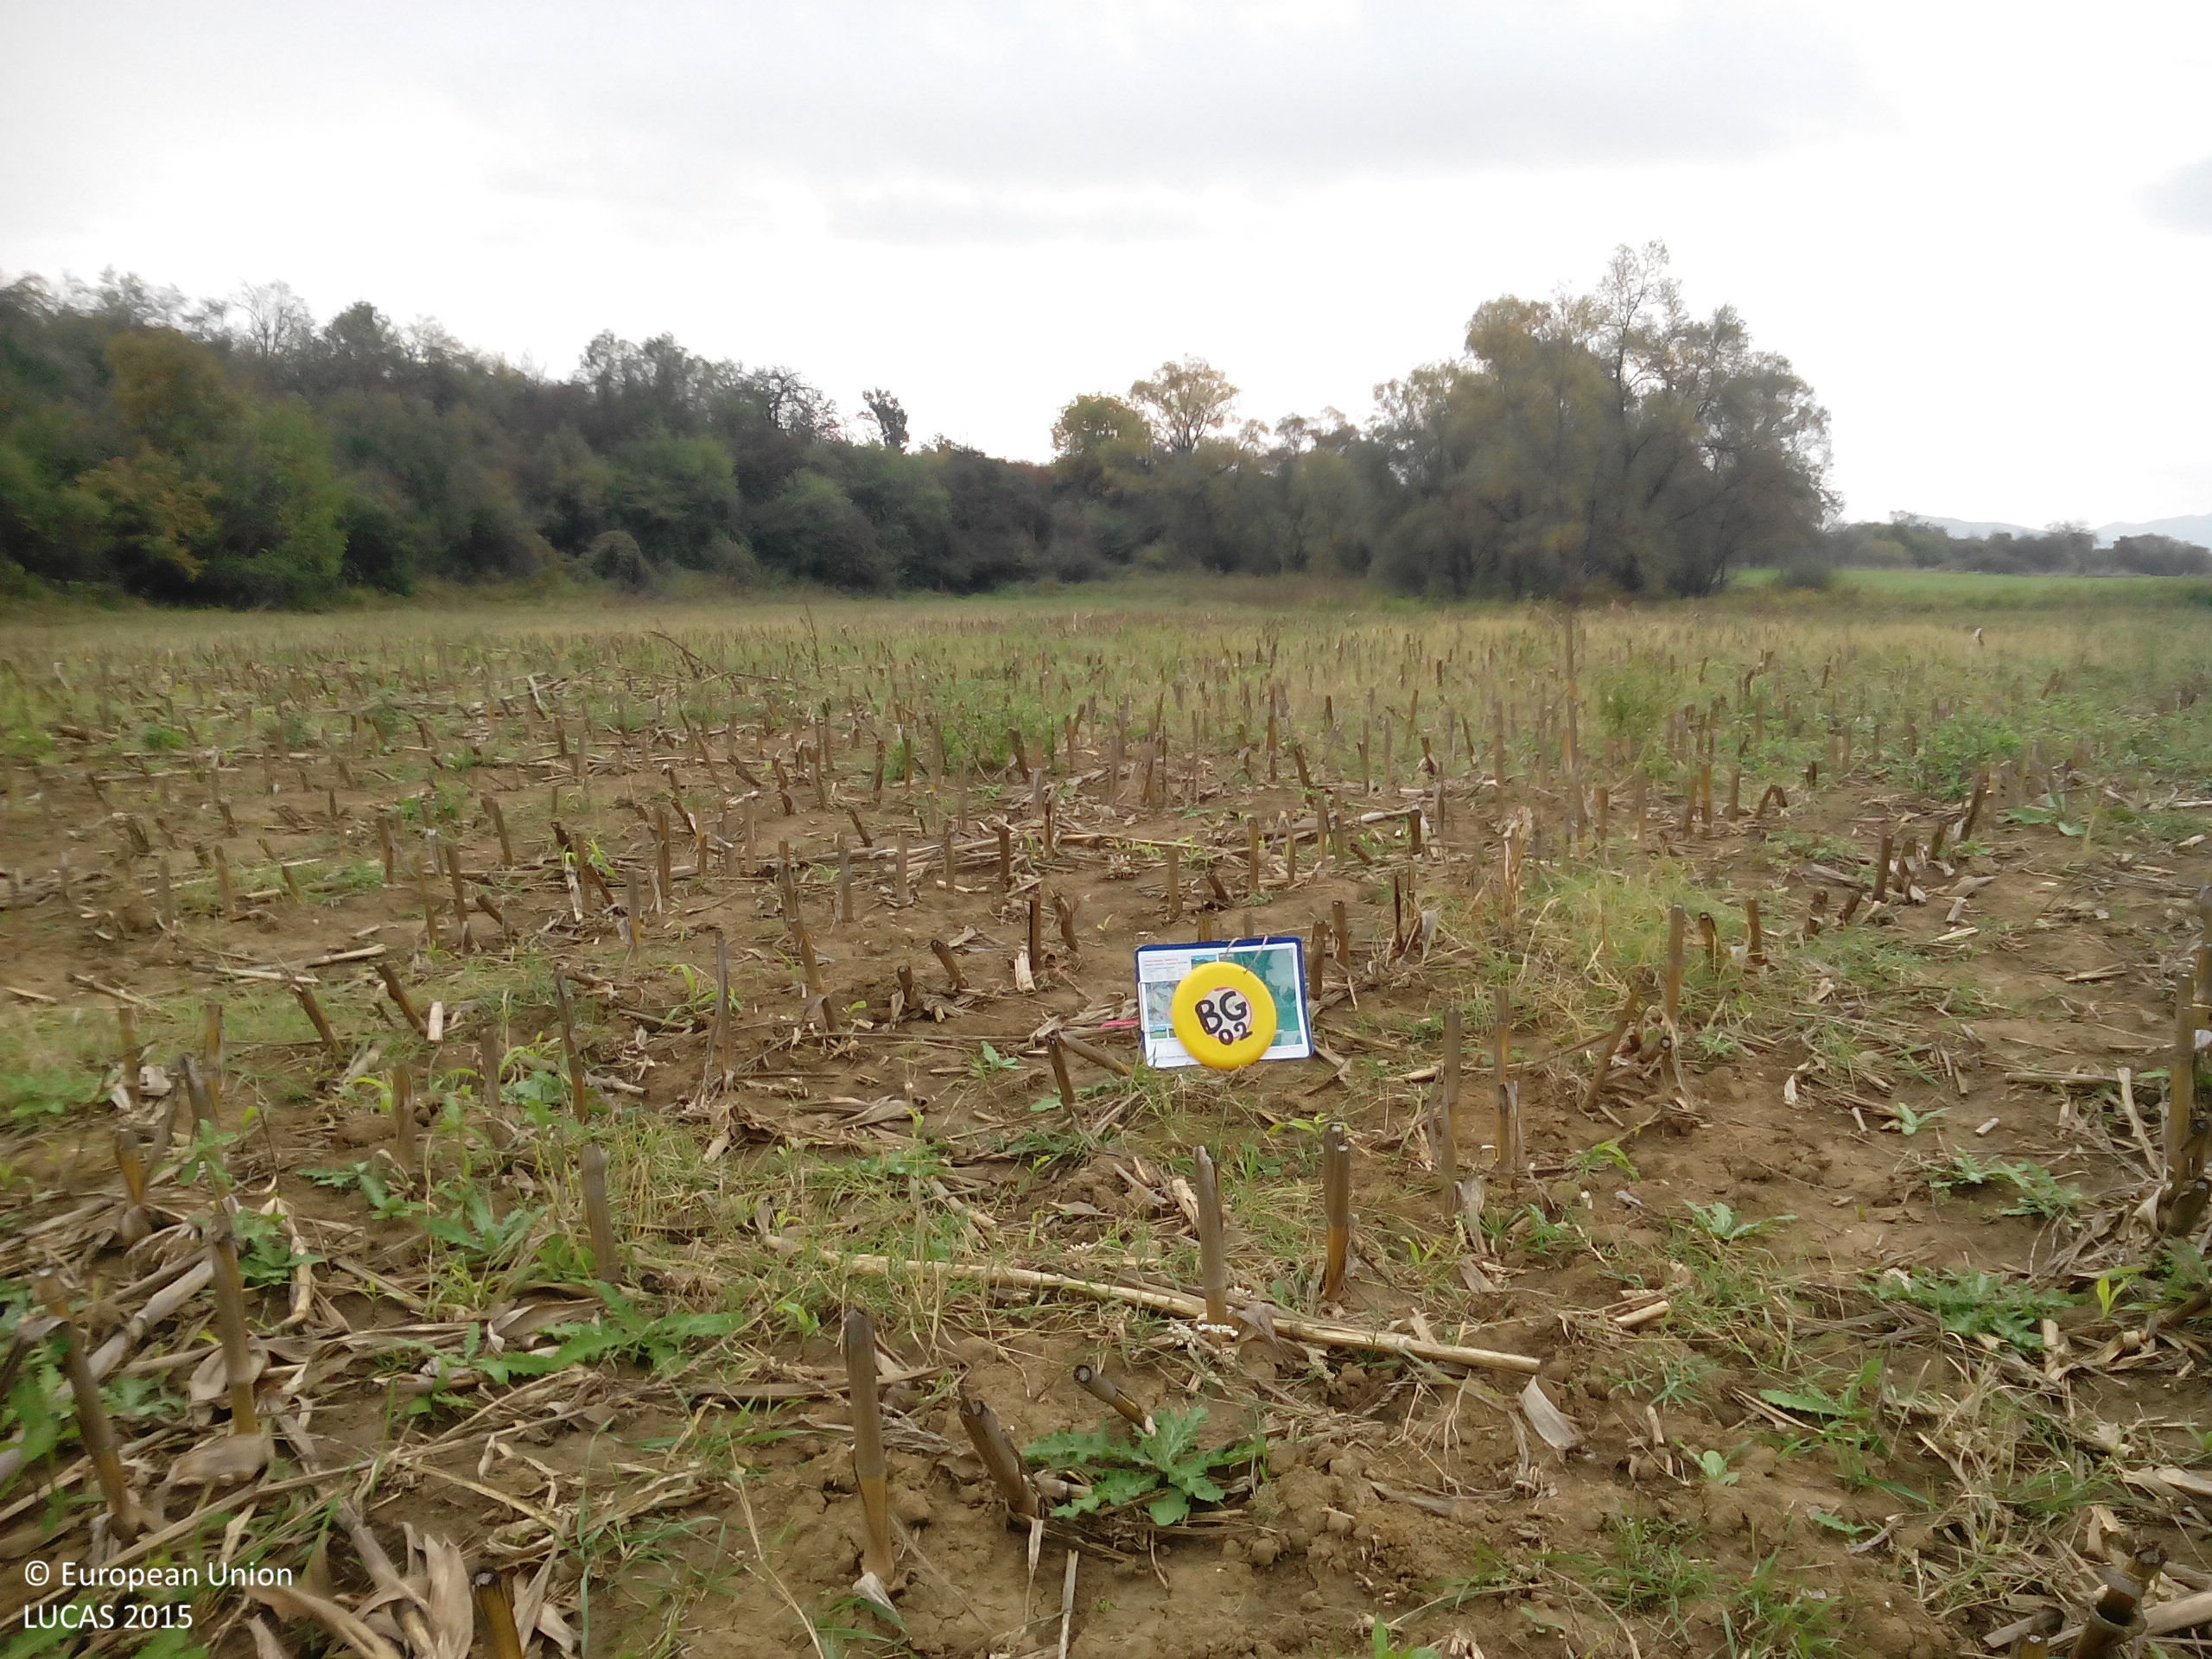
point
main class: Cropland
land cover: Maize
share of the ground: < 10 %
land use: Agriculture (excluding fallow land and kitchen gardens)
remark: Harvested field
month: October
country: BG
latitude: 42.9912
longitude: 24.0178
